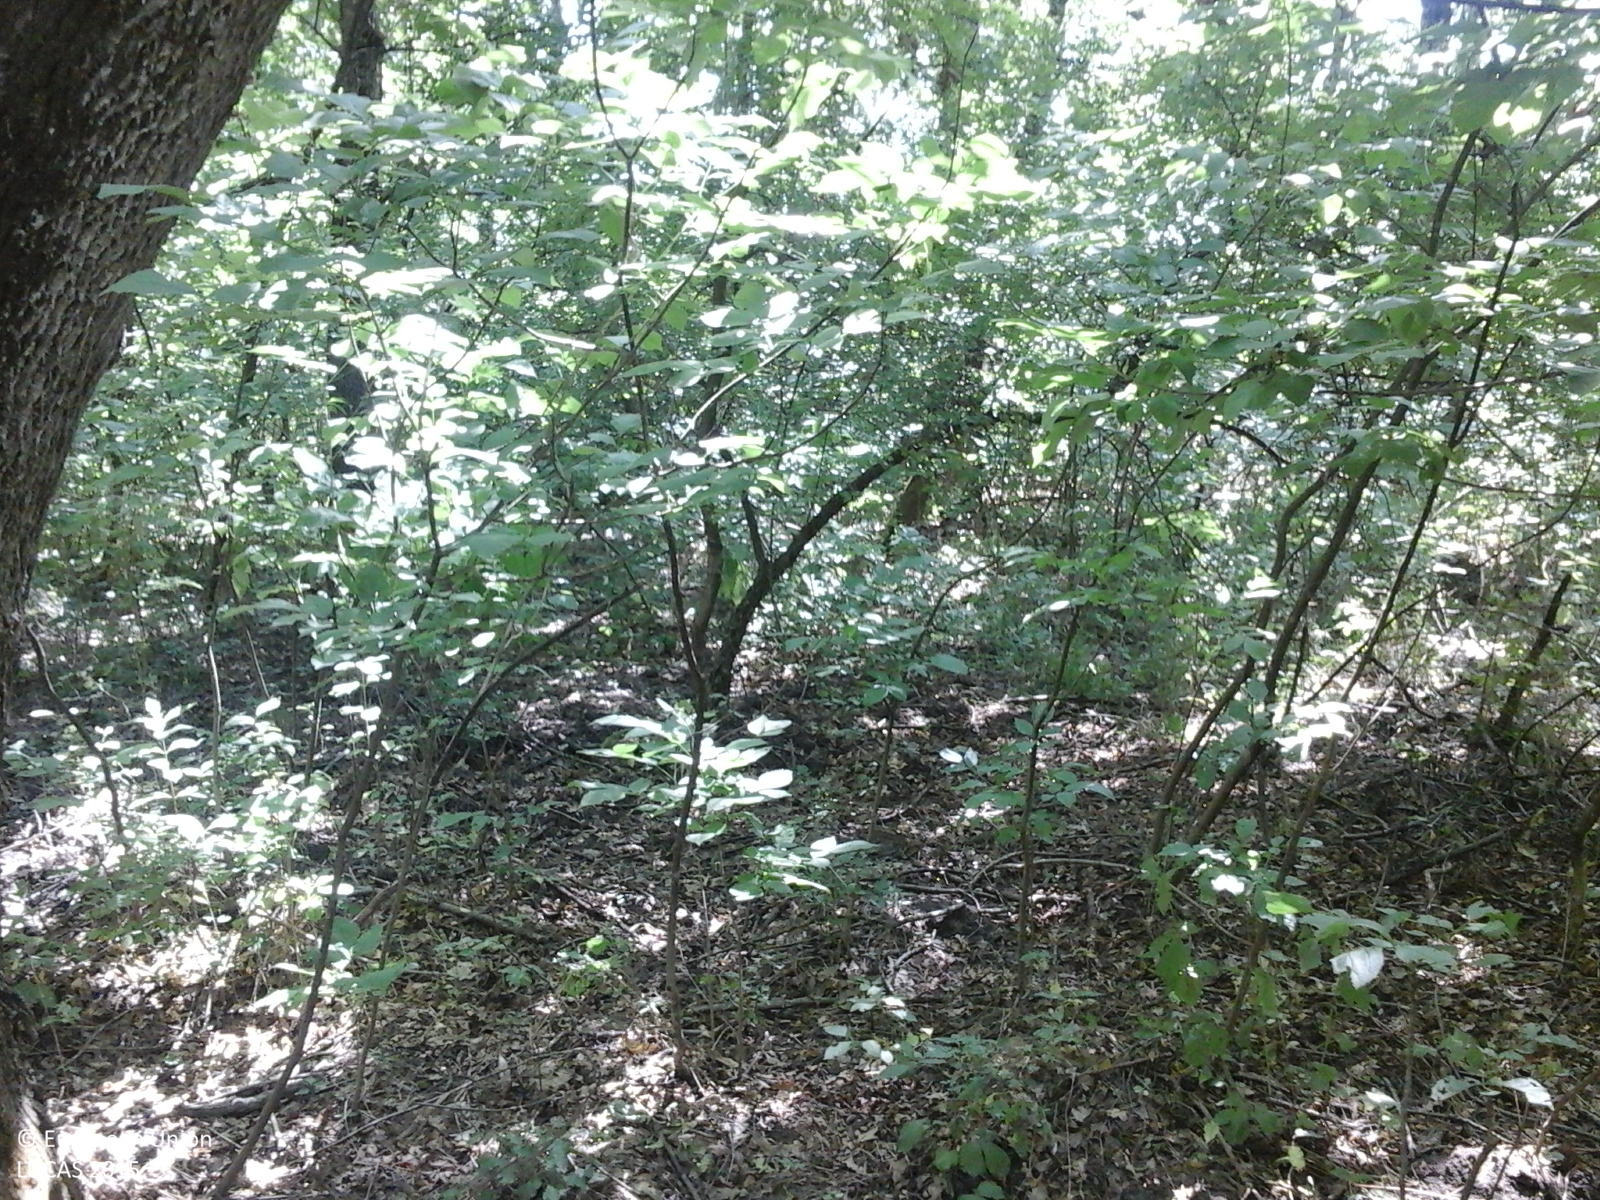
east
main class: Woodland
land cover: Broadleaved woodland
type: acidophilous oak and oak-birch forest
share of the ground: > 75 %
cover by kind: broadleaved forest trees 100 %
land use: Forestry
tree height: > 5 m
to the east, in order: Broadleaved woodland; Grassland without tree/shrub cover; Tracks; Rape and turnip rape
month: July
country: RO
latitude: 44.4130
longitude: 26.4004
